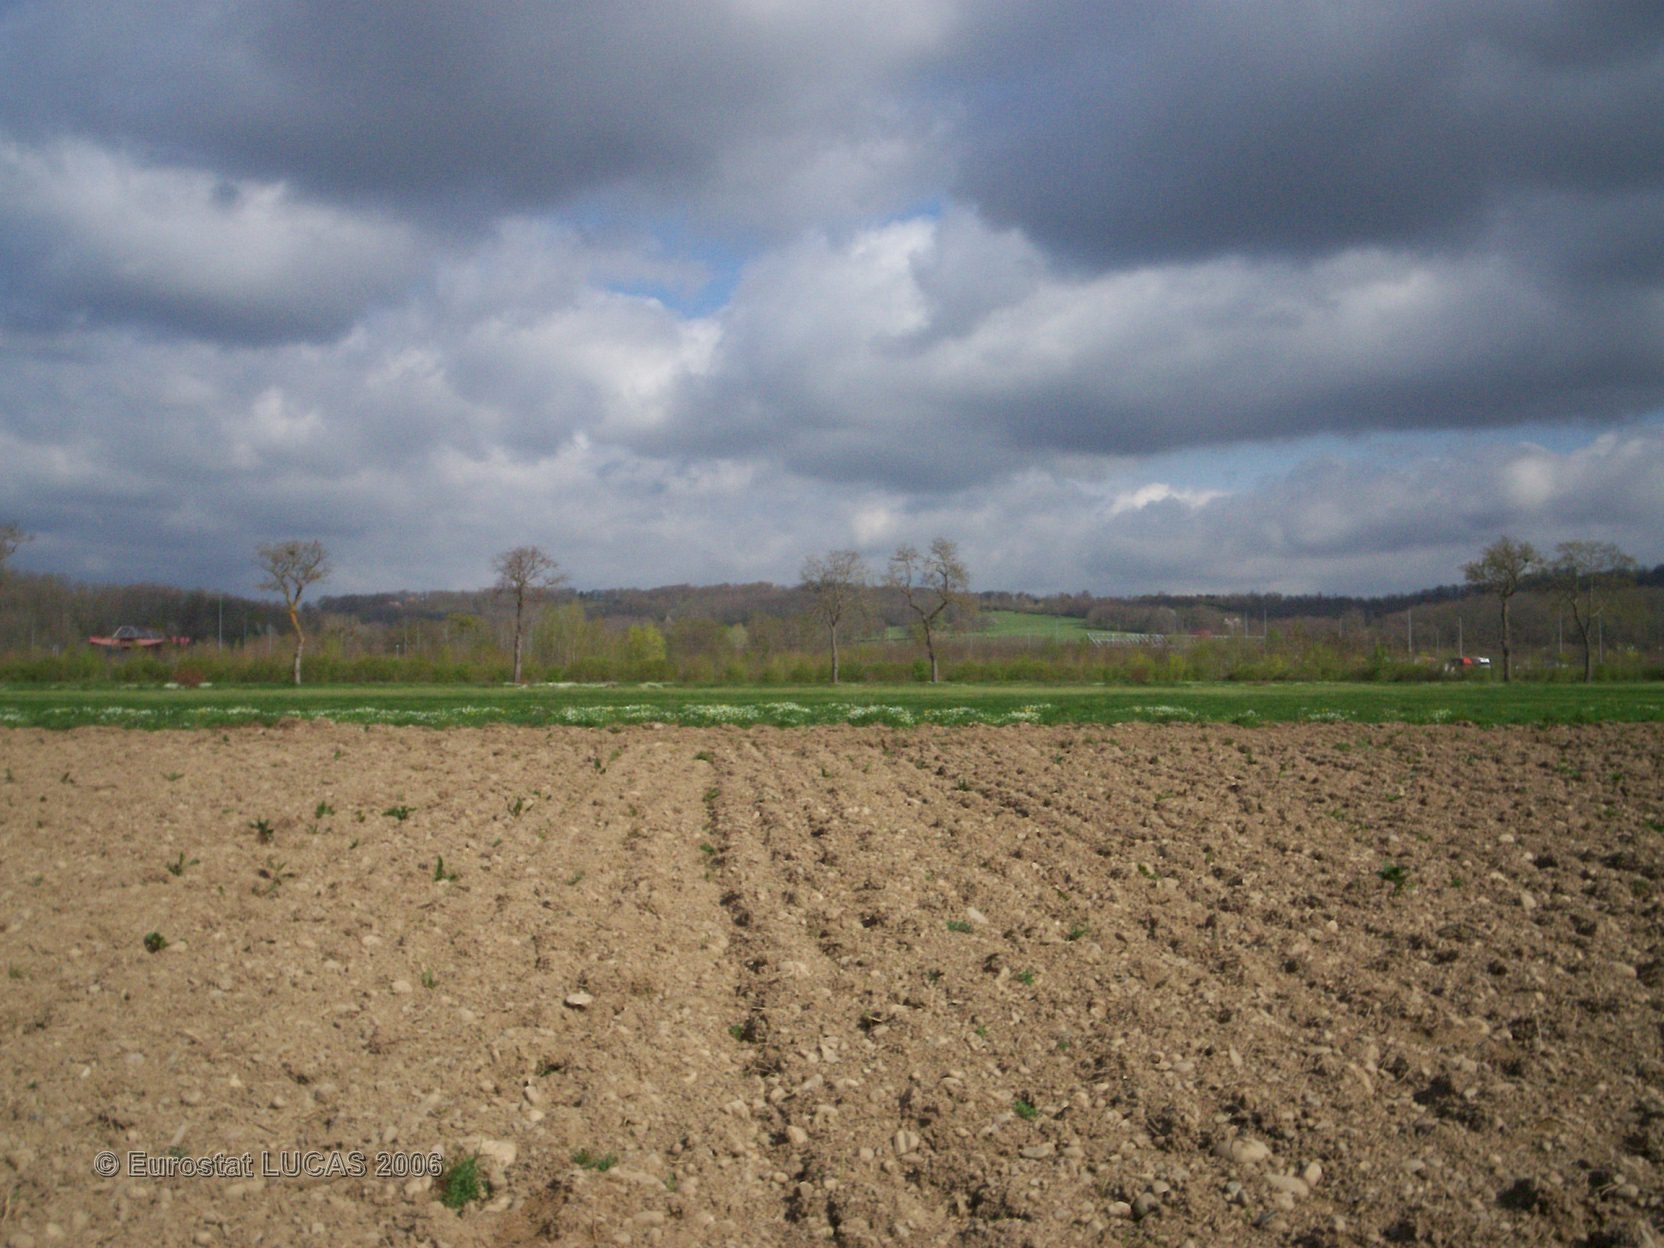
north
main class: Cropland
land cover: Other fibre and oleaginous crops
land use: Agriculture (excluding fallow land and kitchen gardens)
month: June
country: FR
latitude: 43.1149
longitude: 0.8961
